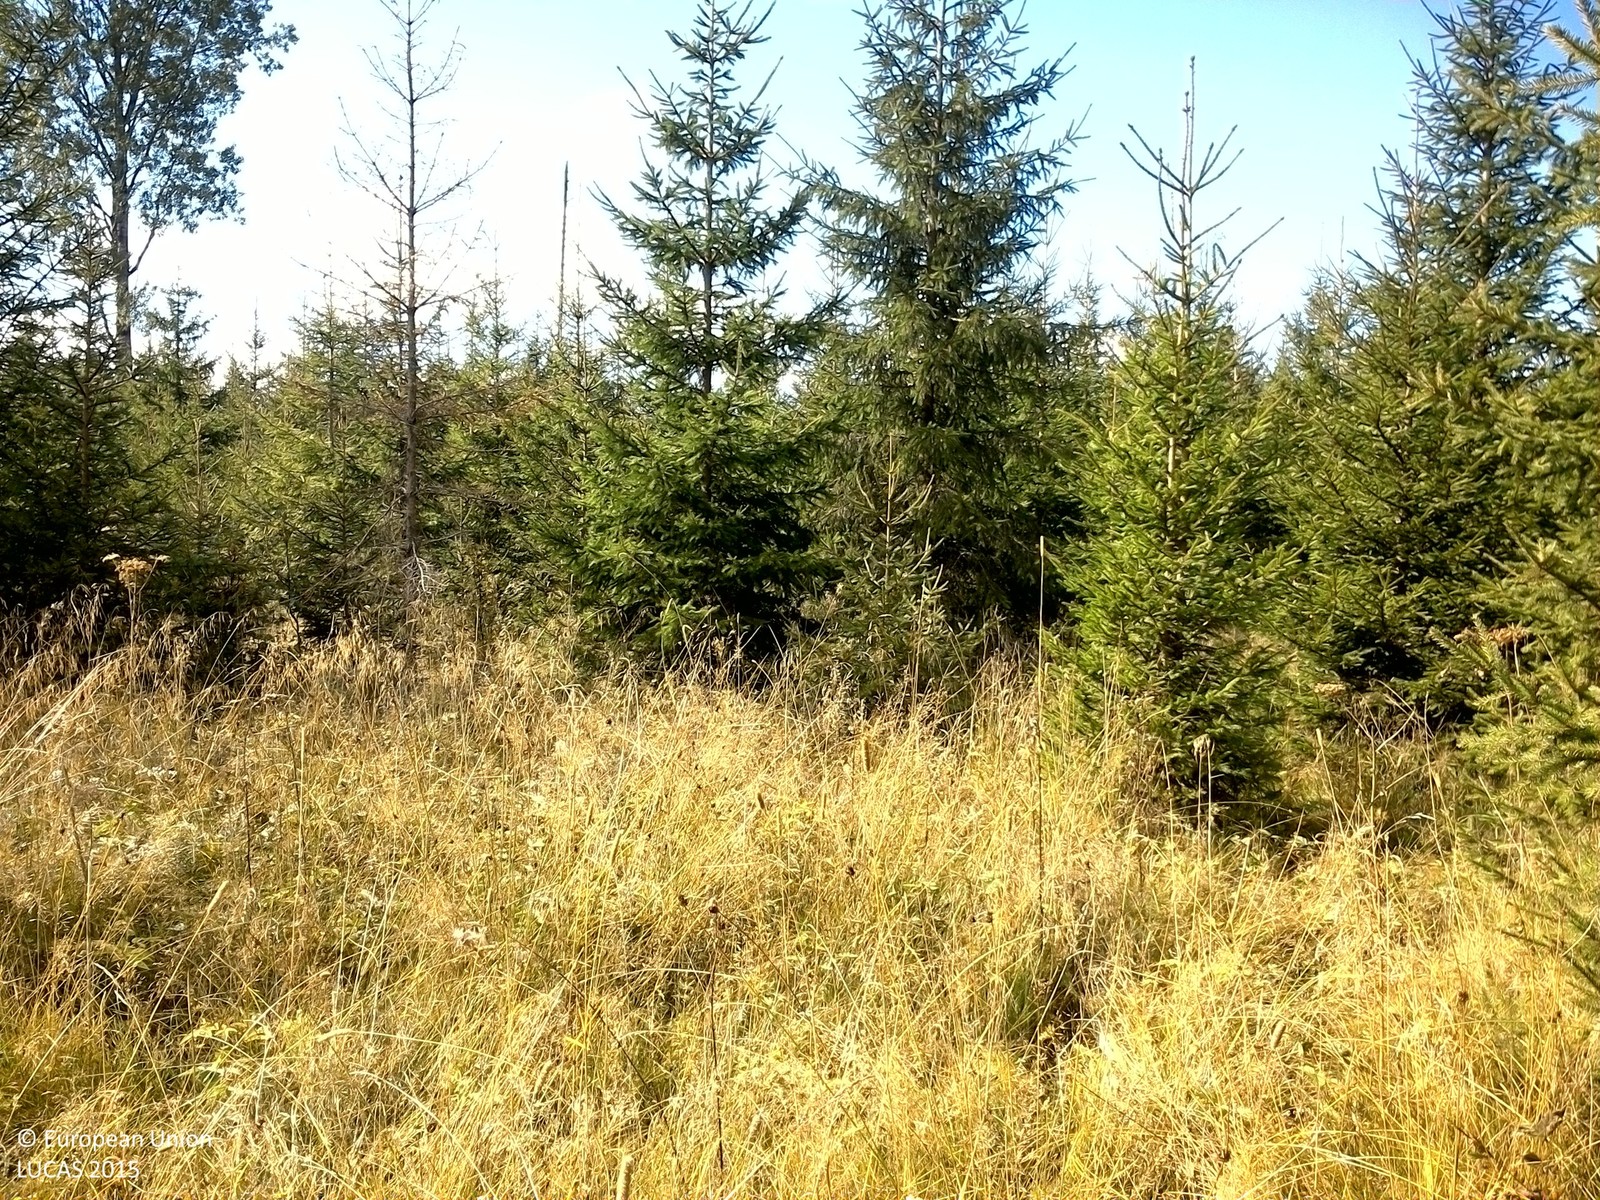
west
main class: Grassland
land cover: Grassland with sparse tree/shrub cover
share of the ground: > 75 %
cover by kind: herbaceous plants 85 %, coniferous forest trees 5 %, shrubs 5 %, consolidated bare surface 5 %
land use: Forestry
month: September
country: SE
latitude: 59.6407
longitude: 13.1673
